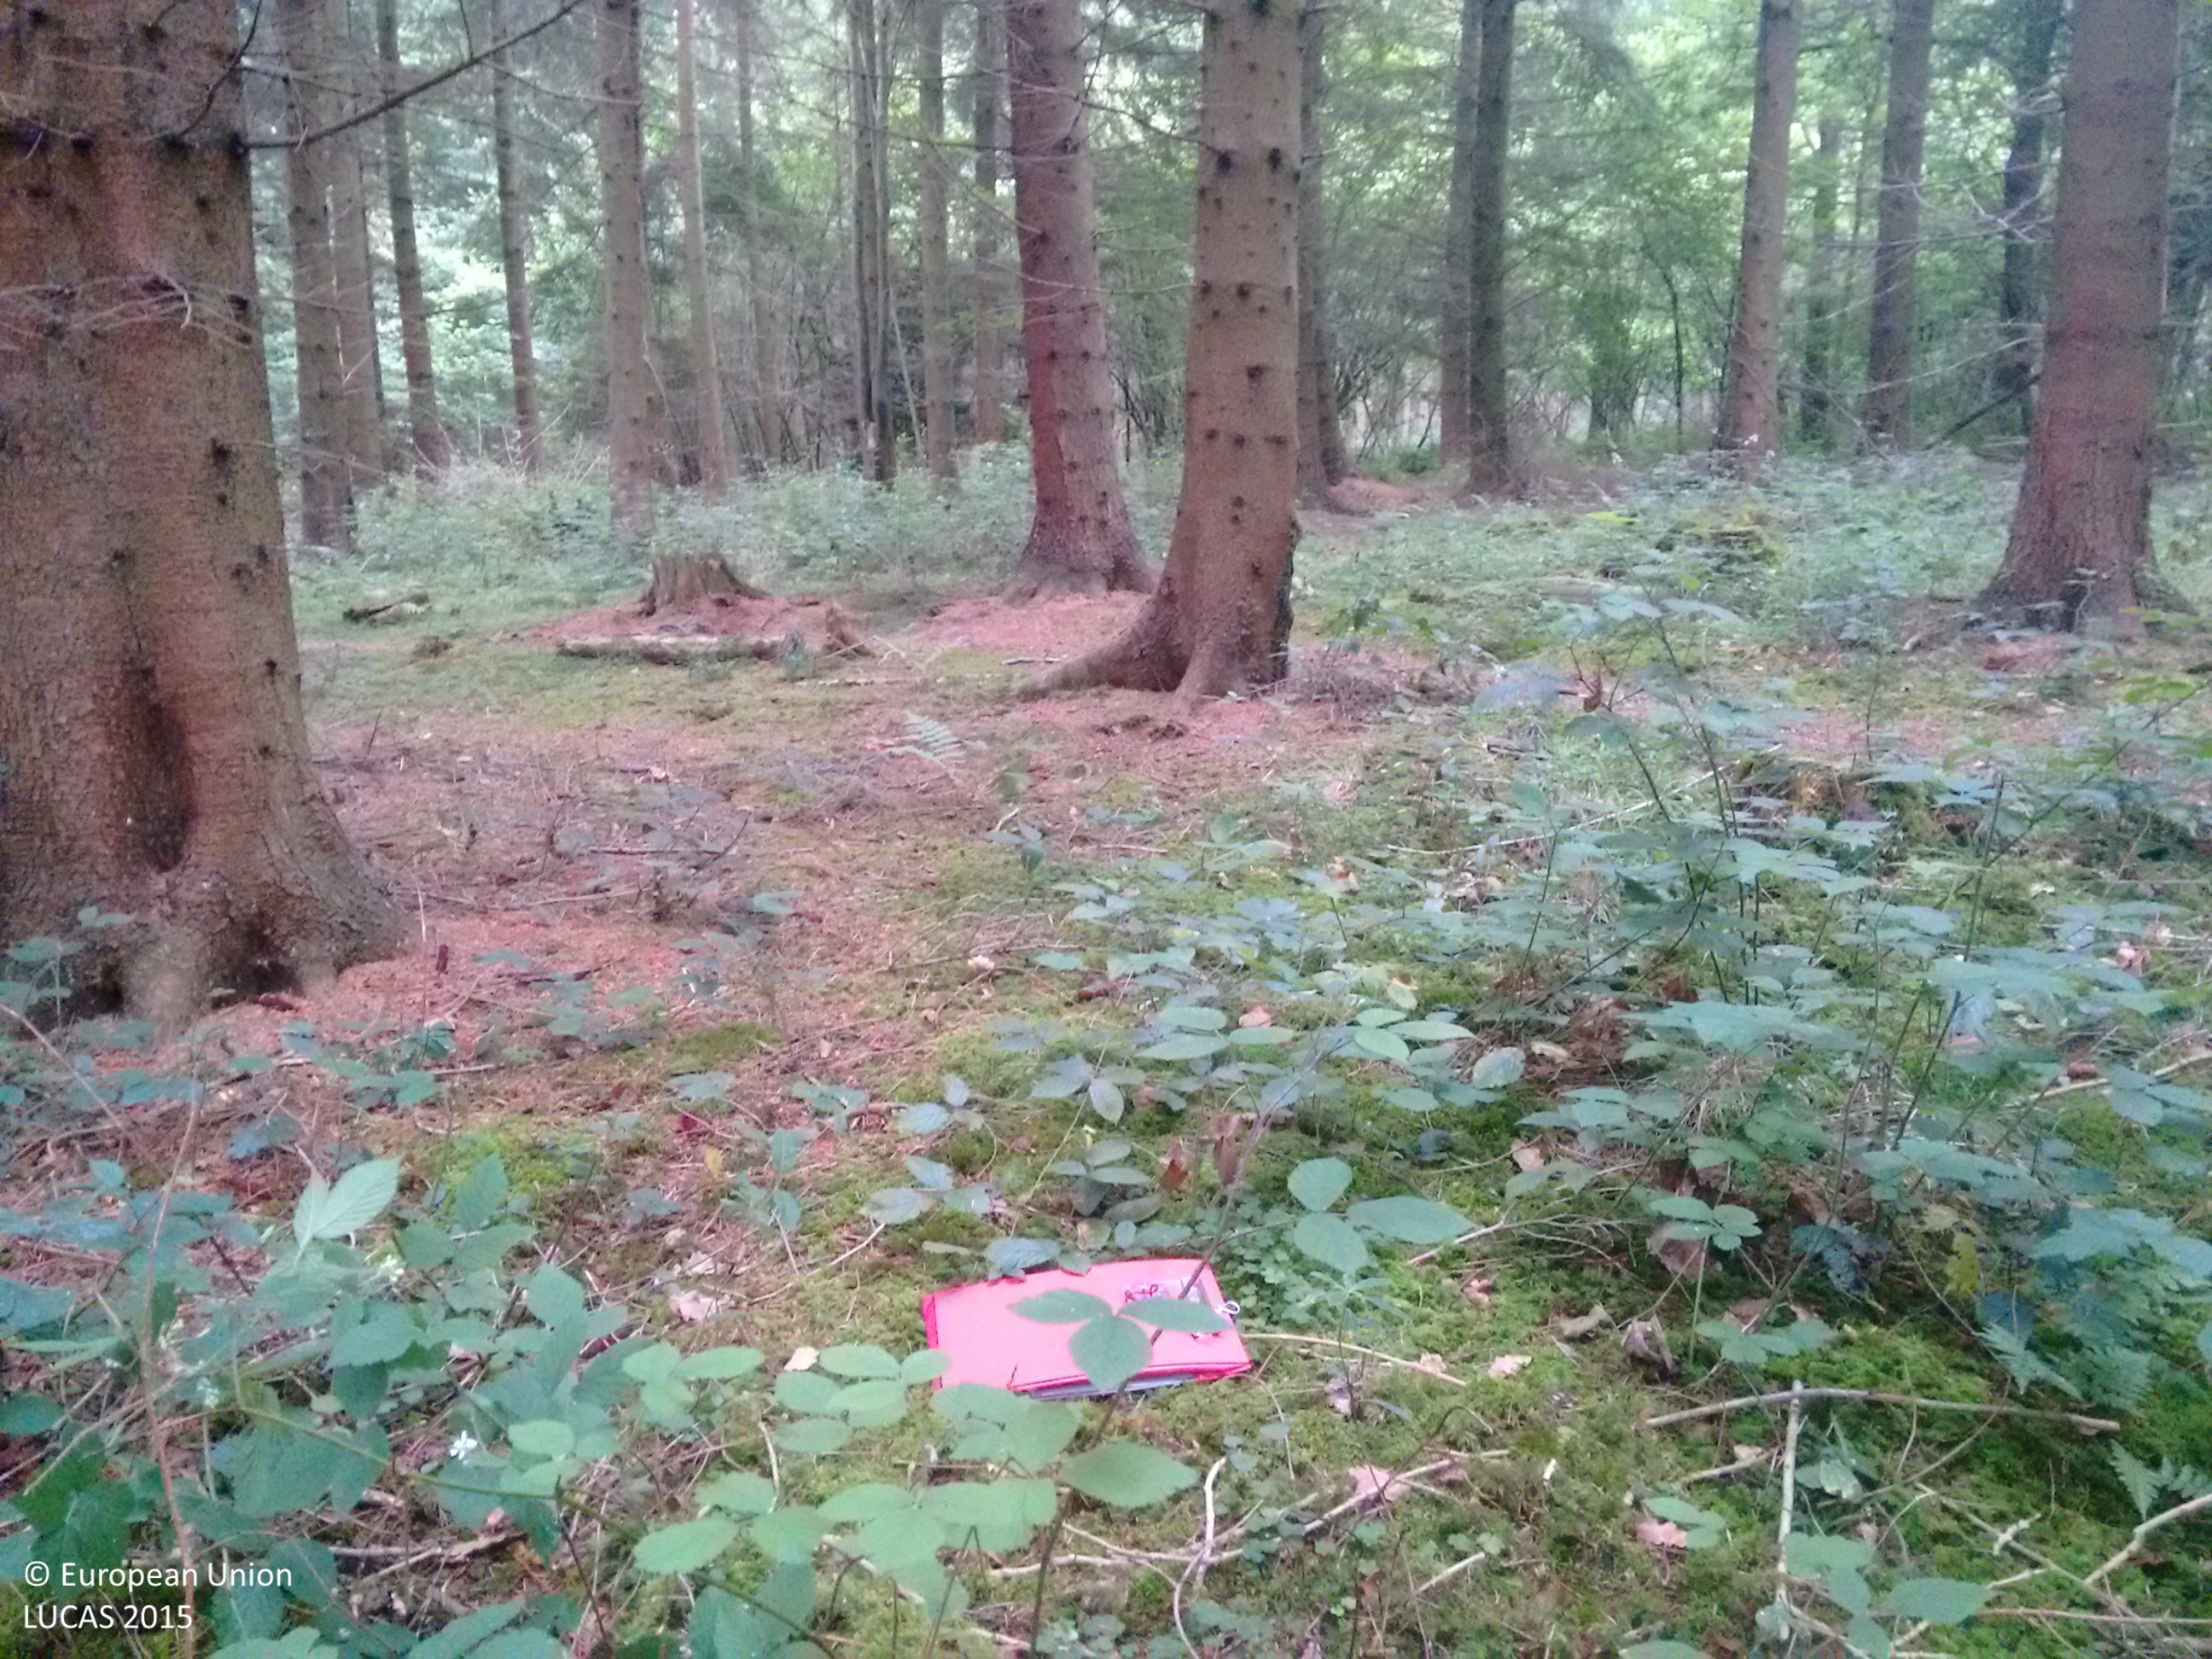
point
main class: Woodland
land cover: Spruce dominated mixed woodland
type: exotic forest
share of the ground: > 75 %
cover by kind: coniferous forest trees 70 %, broadleaved forest trees 25 %, shrubs 5 %
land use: Forestry
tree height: > 5 m
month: July
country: GB
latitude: 52.0316
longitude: -2.5888
